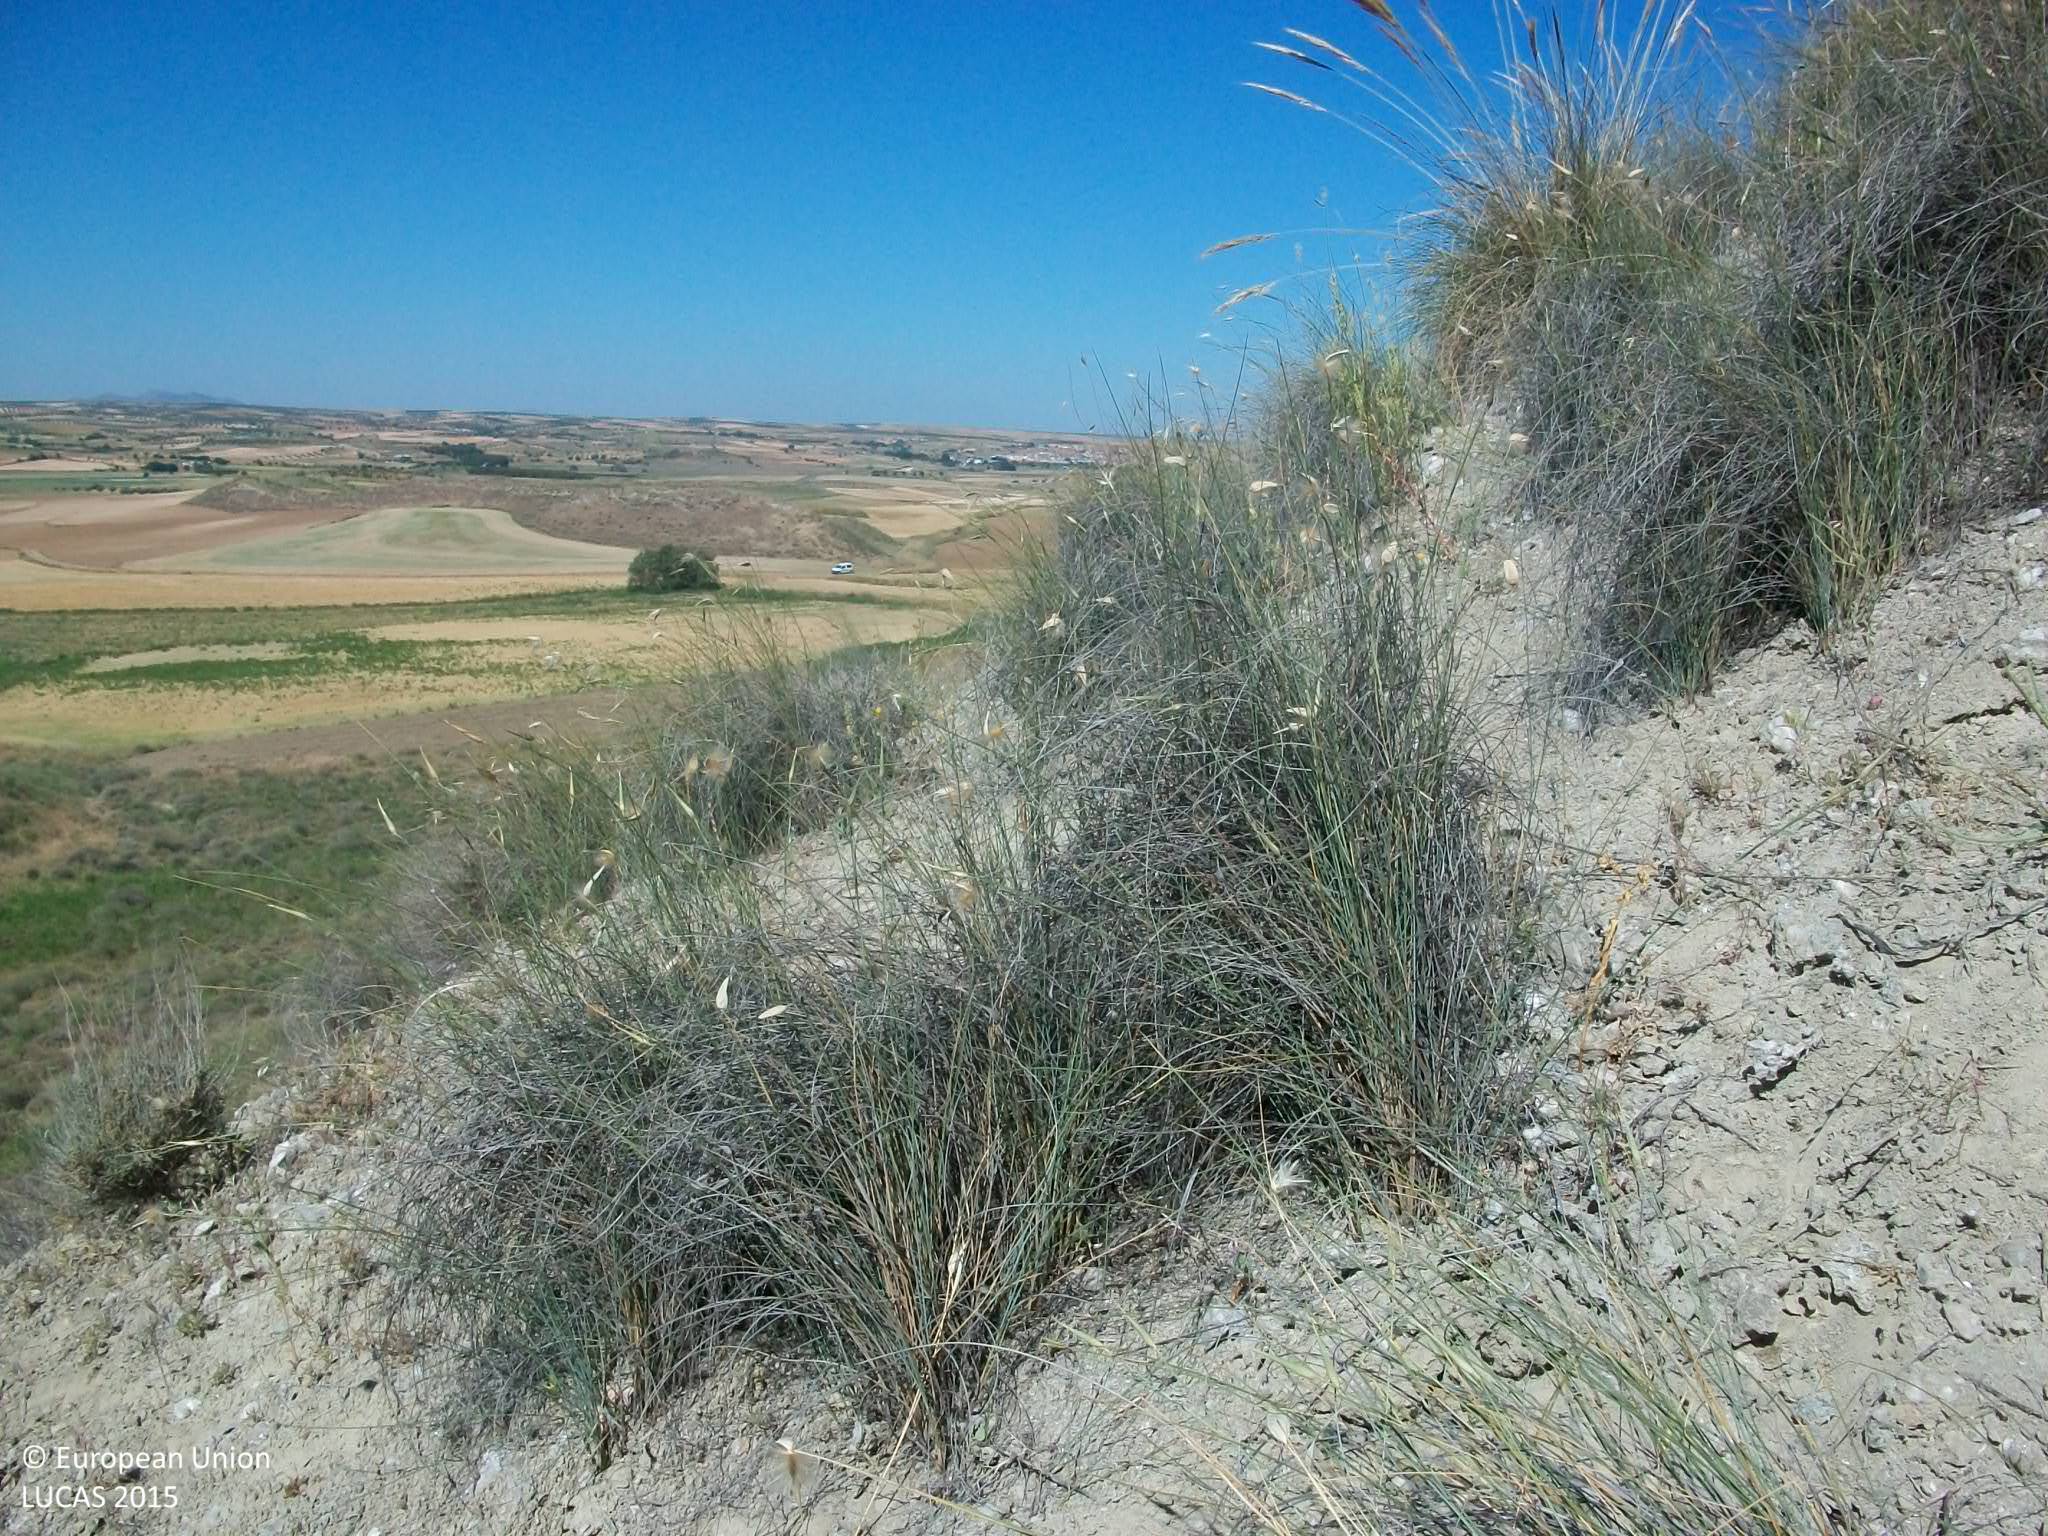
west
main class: Grassland
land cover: Grassland without tree/shrub cover
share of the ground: > 75 %
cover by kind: herbaceous plants 80 %, consolidated bare surface 20 %
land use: Semi-natural and natural areas not in use
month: May
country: ES
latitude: 39.8729
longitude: -3.6741
